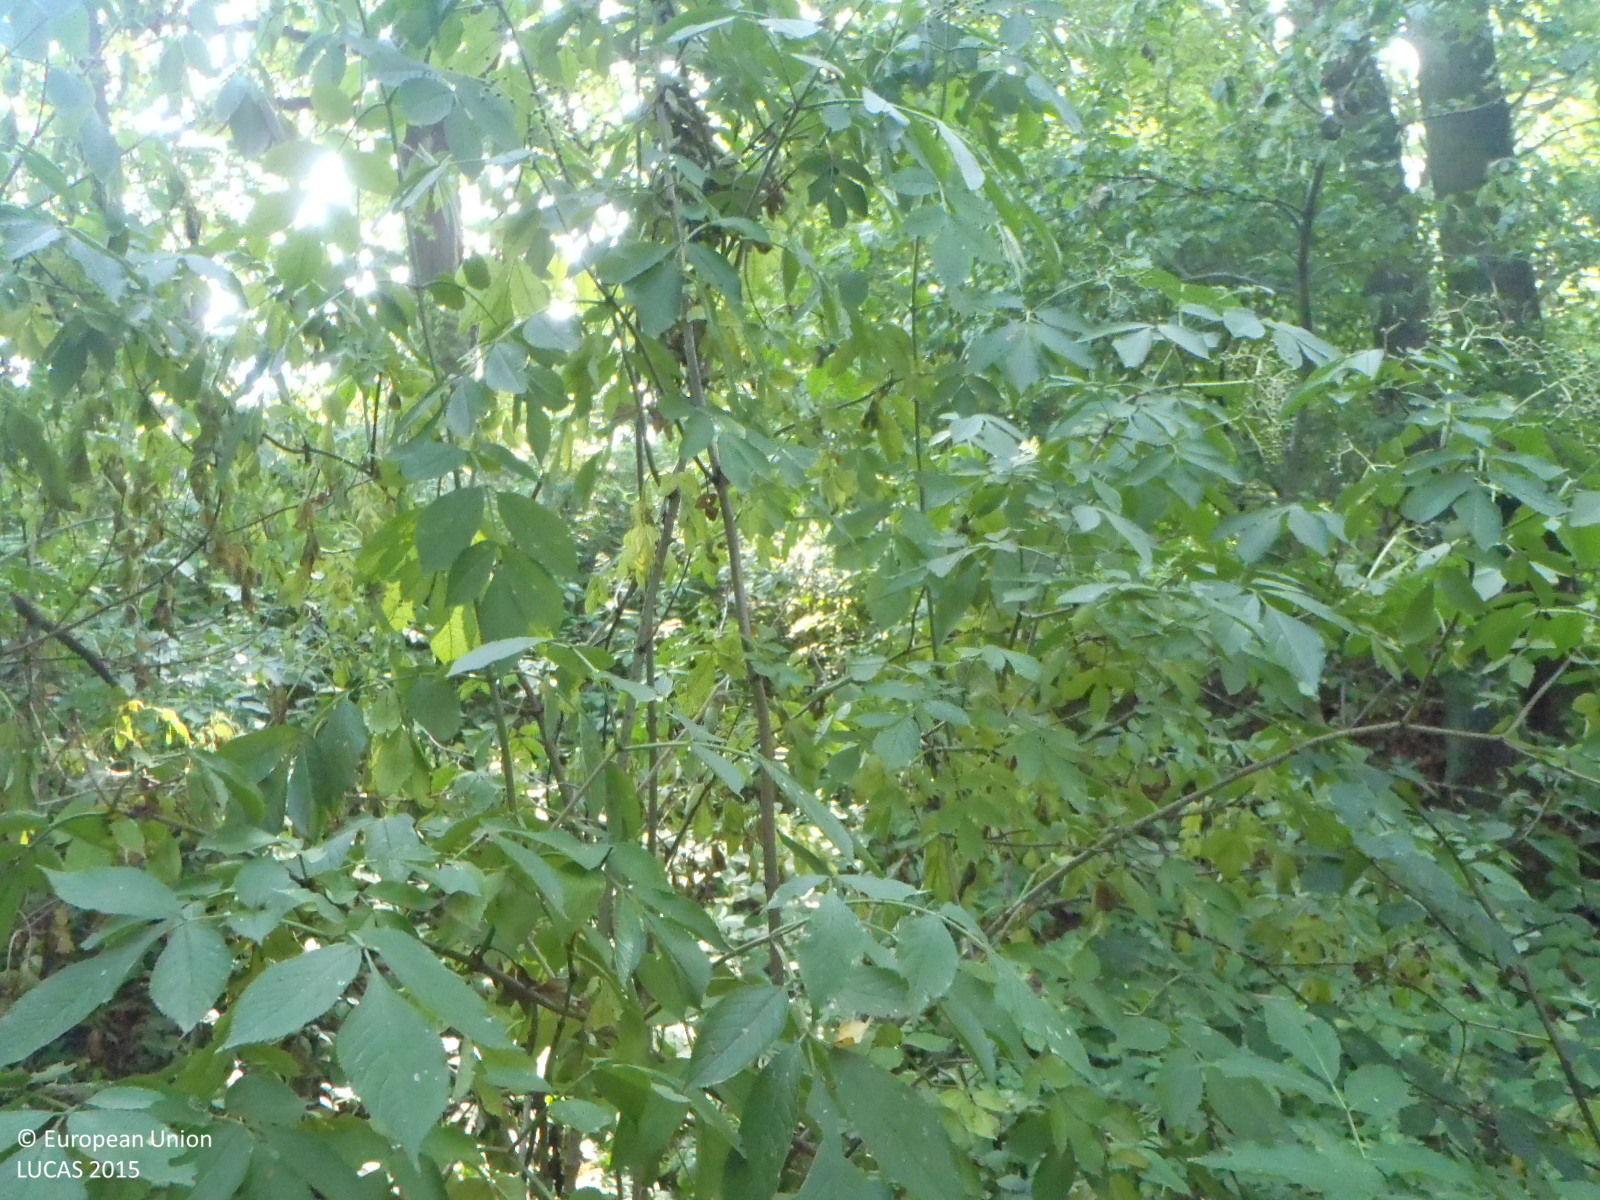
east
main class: Woodland
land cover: Broadleaved woodland
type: mesophytic deciduous forest
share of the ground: > 75 %
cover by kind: broadleaved forest trees 95 %, herbaceous plants 5 %
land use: Forestry
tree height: > 5 m
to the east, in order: Broadleaved woodland; Paved roads, cycling and walking lanes; Ditches and canals; Broadleaved woodland; Spontaneously vegetated surfaces; Rape and turnip rape
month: August
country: CZ
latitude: 50.7070
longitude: 14.5191
